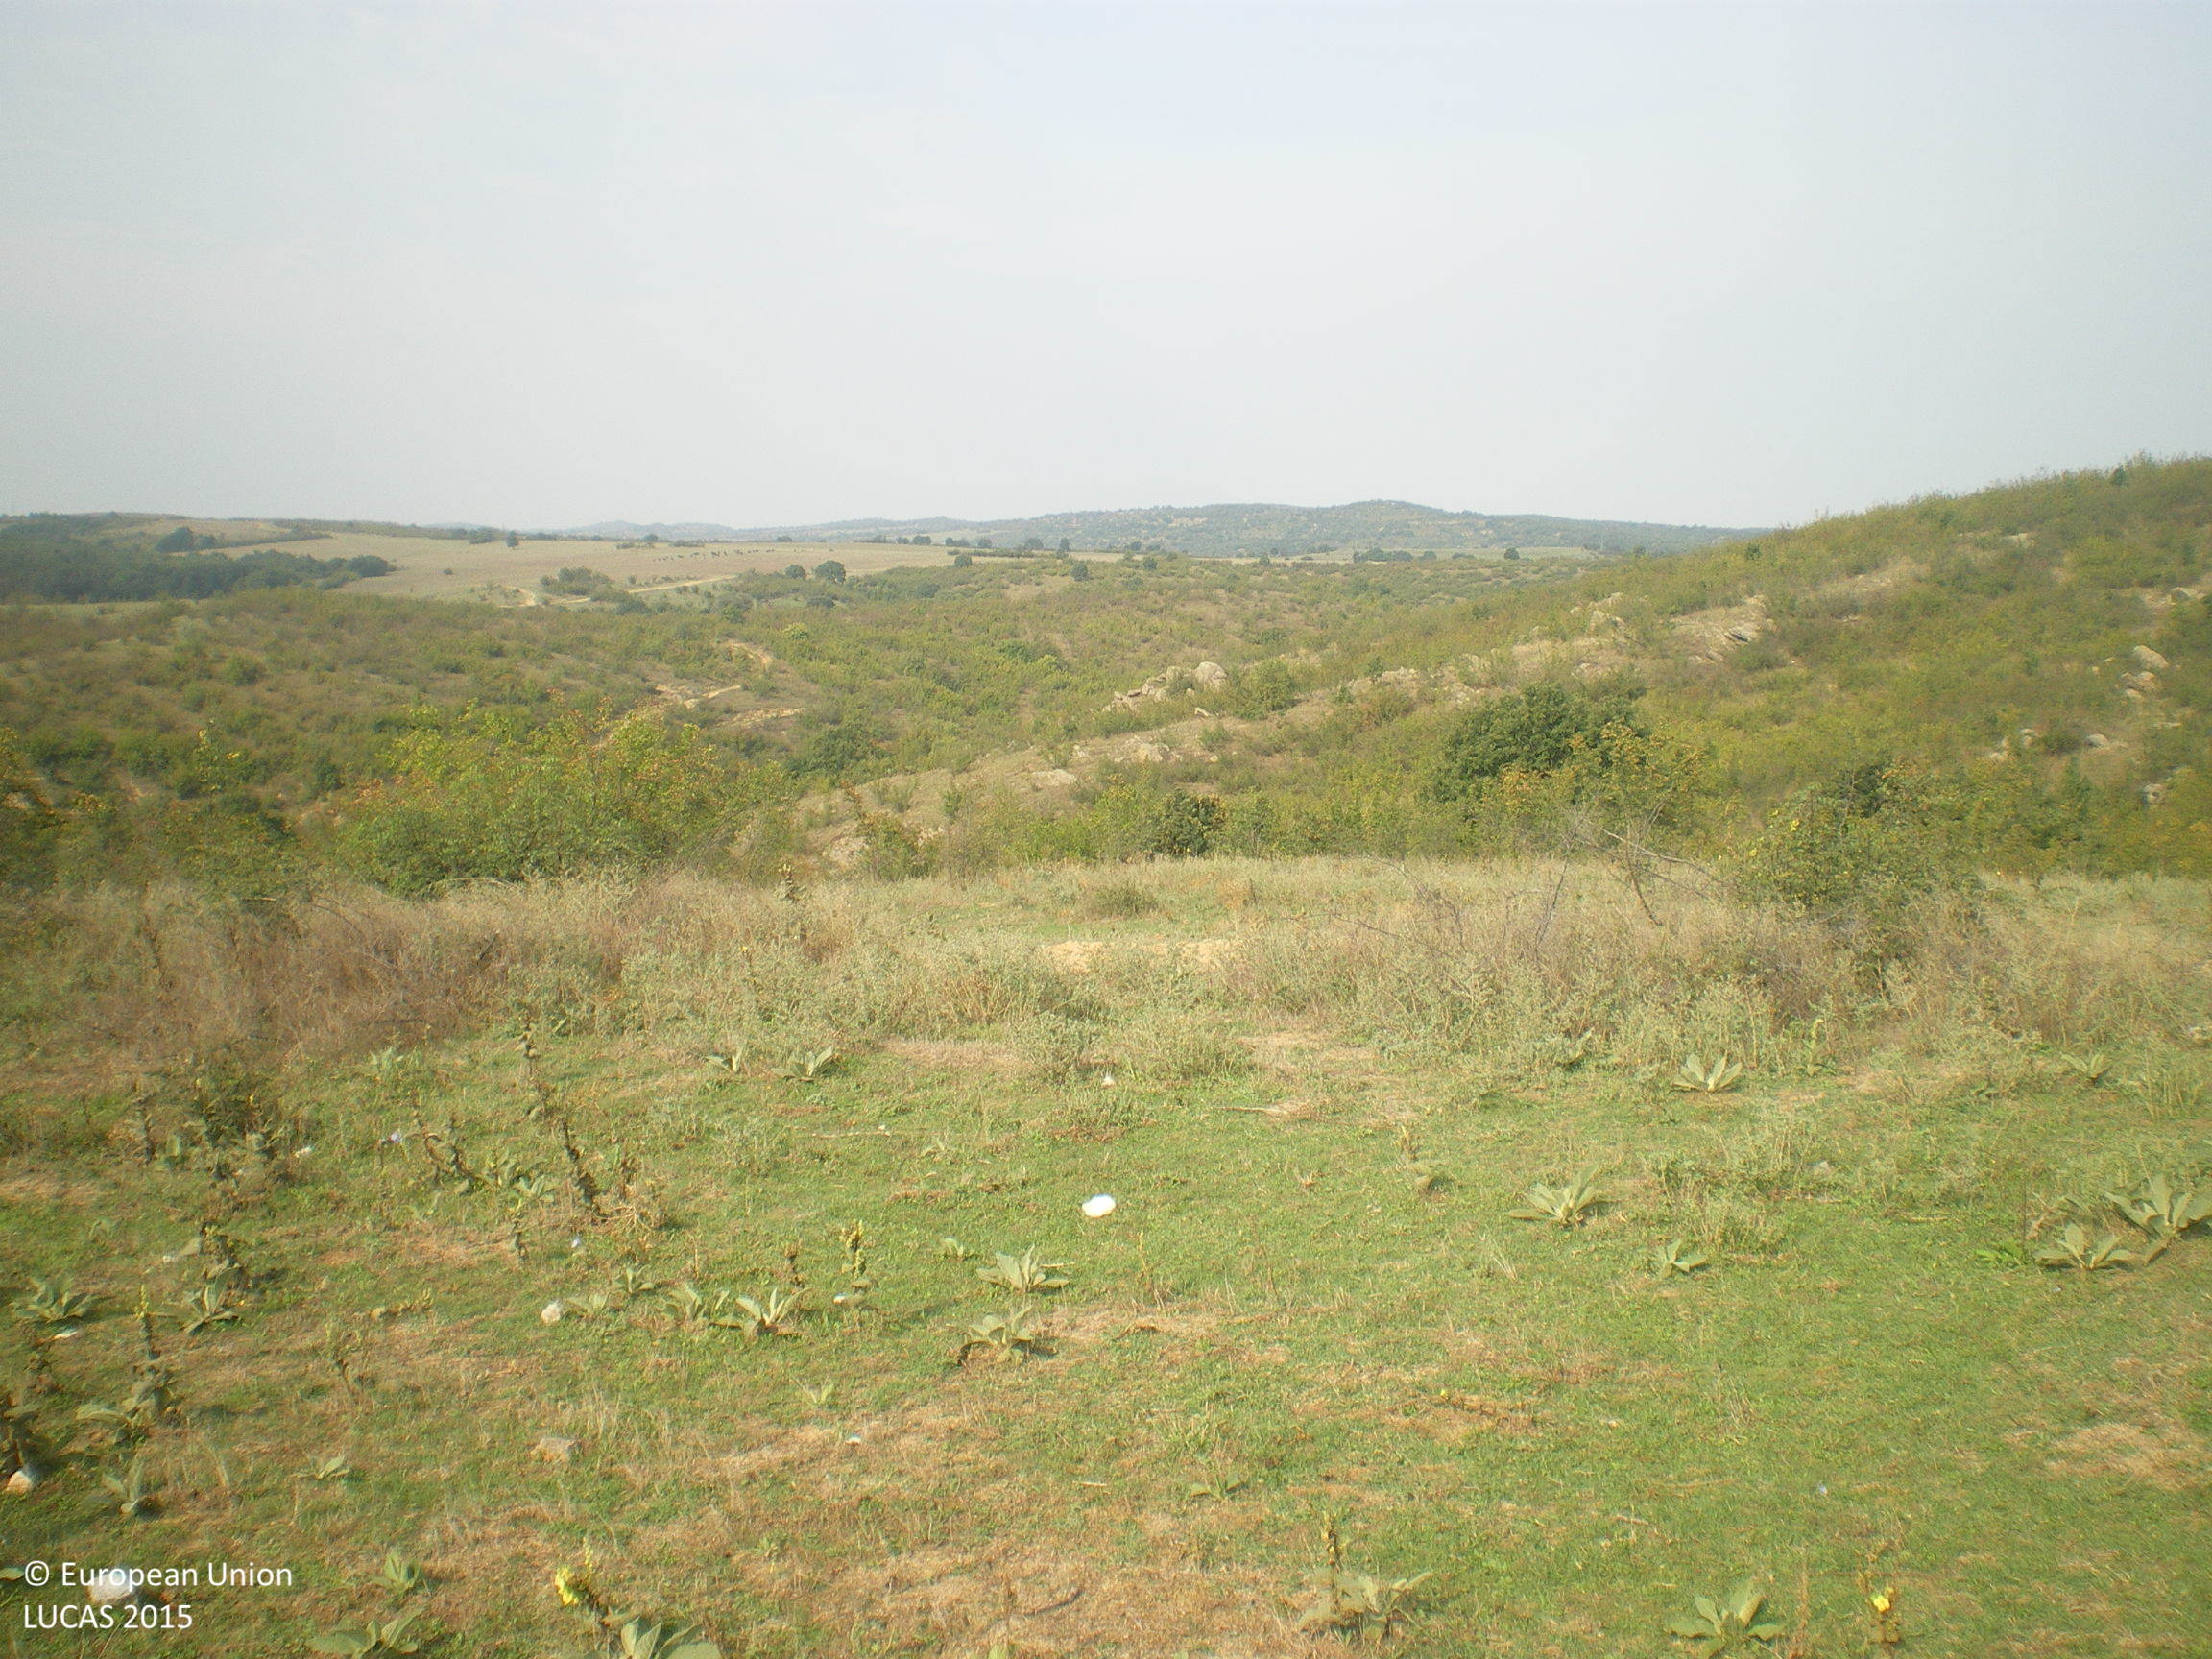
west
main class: Grassland
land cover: Grassland without tree/shrub cover
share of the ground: > 75 %
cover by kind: herbaceous plants 100 %
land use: Agriculture (excluding fallow land and kitchen gardens)
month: September
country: BG
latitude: 41.9033
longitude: 25.8986
